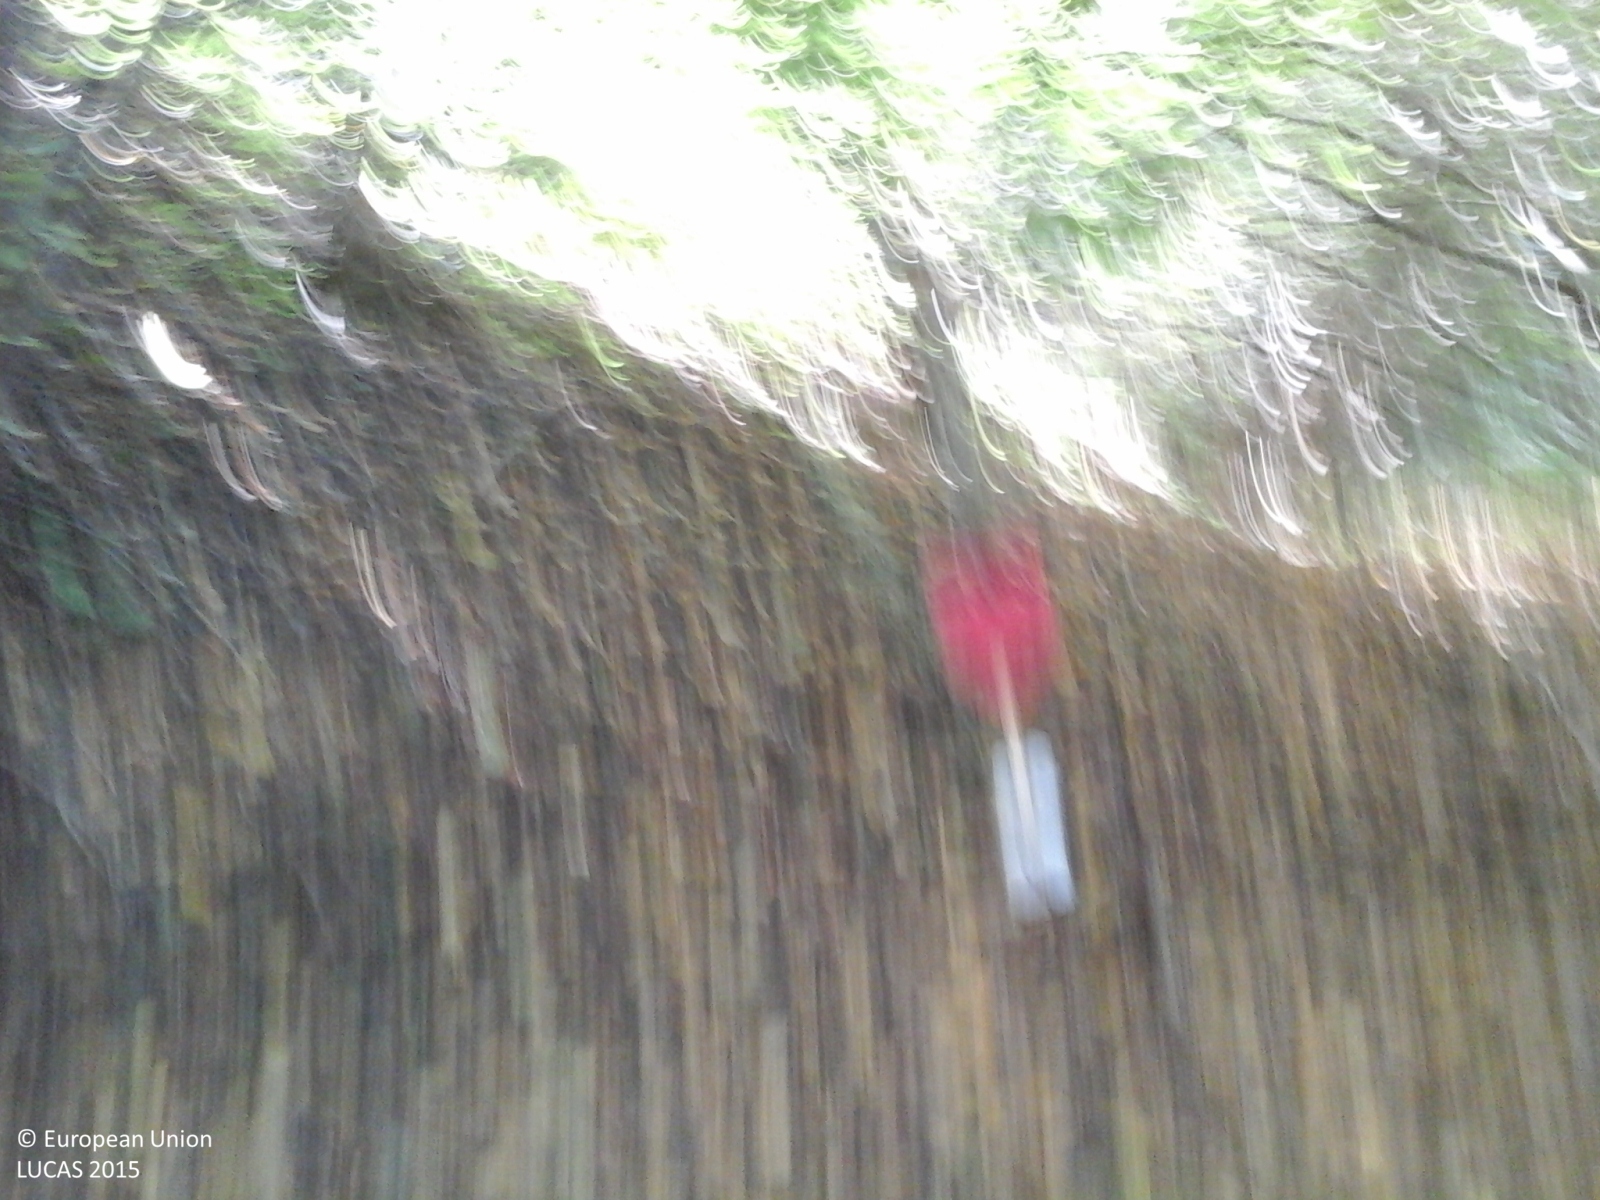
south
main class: Woodland
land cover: Broadleaved woodland
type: thermophilous deciduous forest
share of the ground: > 75 %
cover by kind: broadleaved forest trees 80 %, shrubs 20 %
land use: Semi-natural and natural areas not in use
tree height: > 5 m
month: September
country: IT
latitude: 44.5018
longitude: 8.4814
